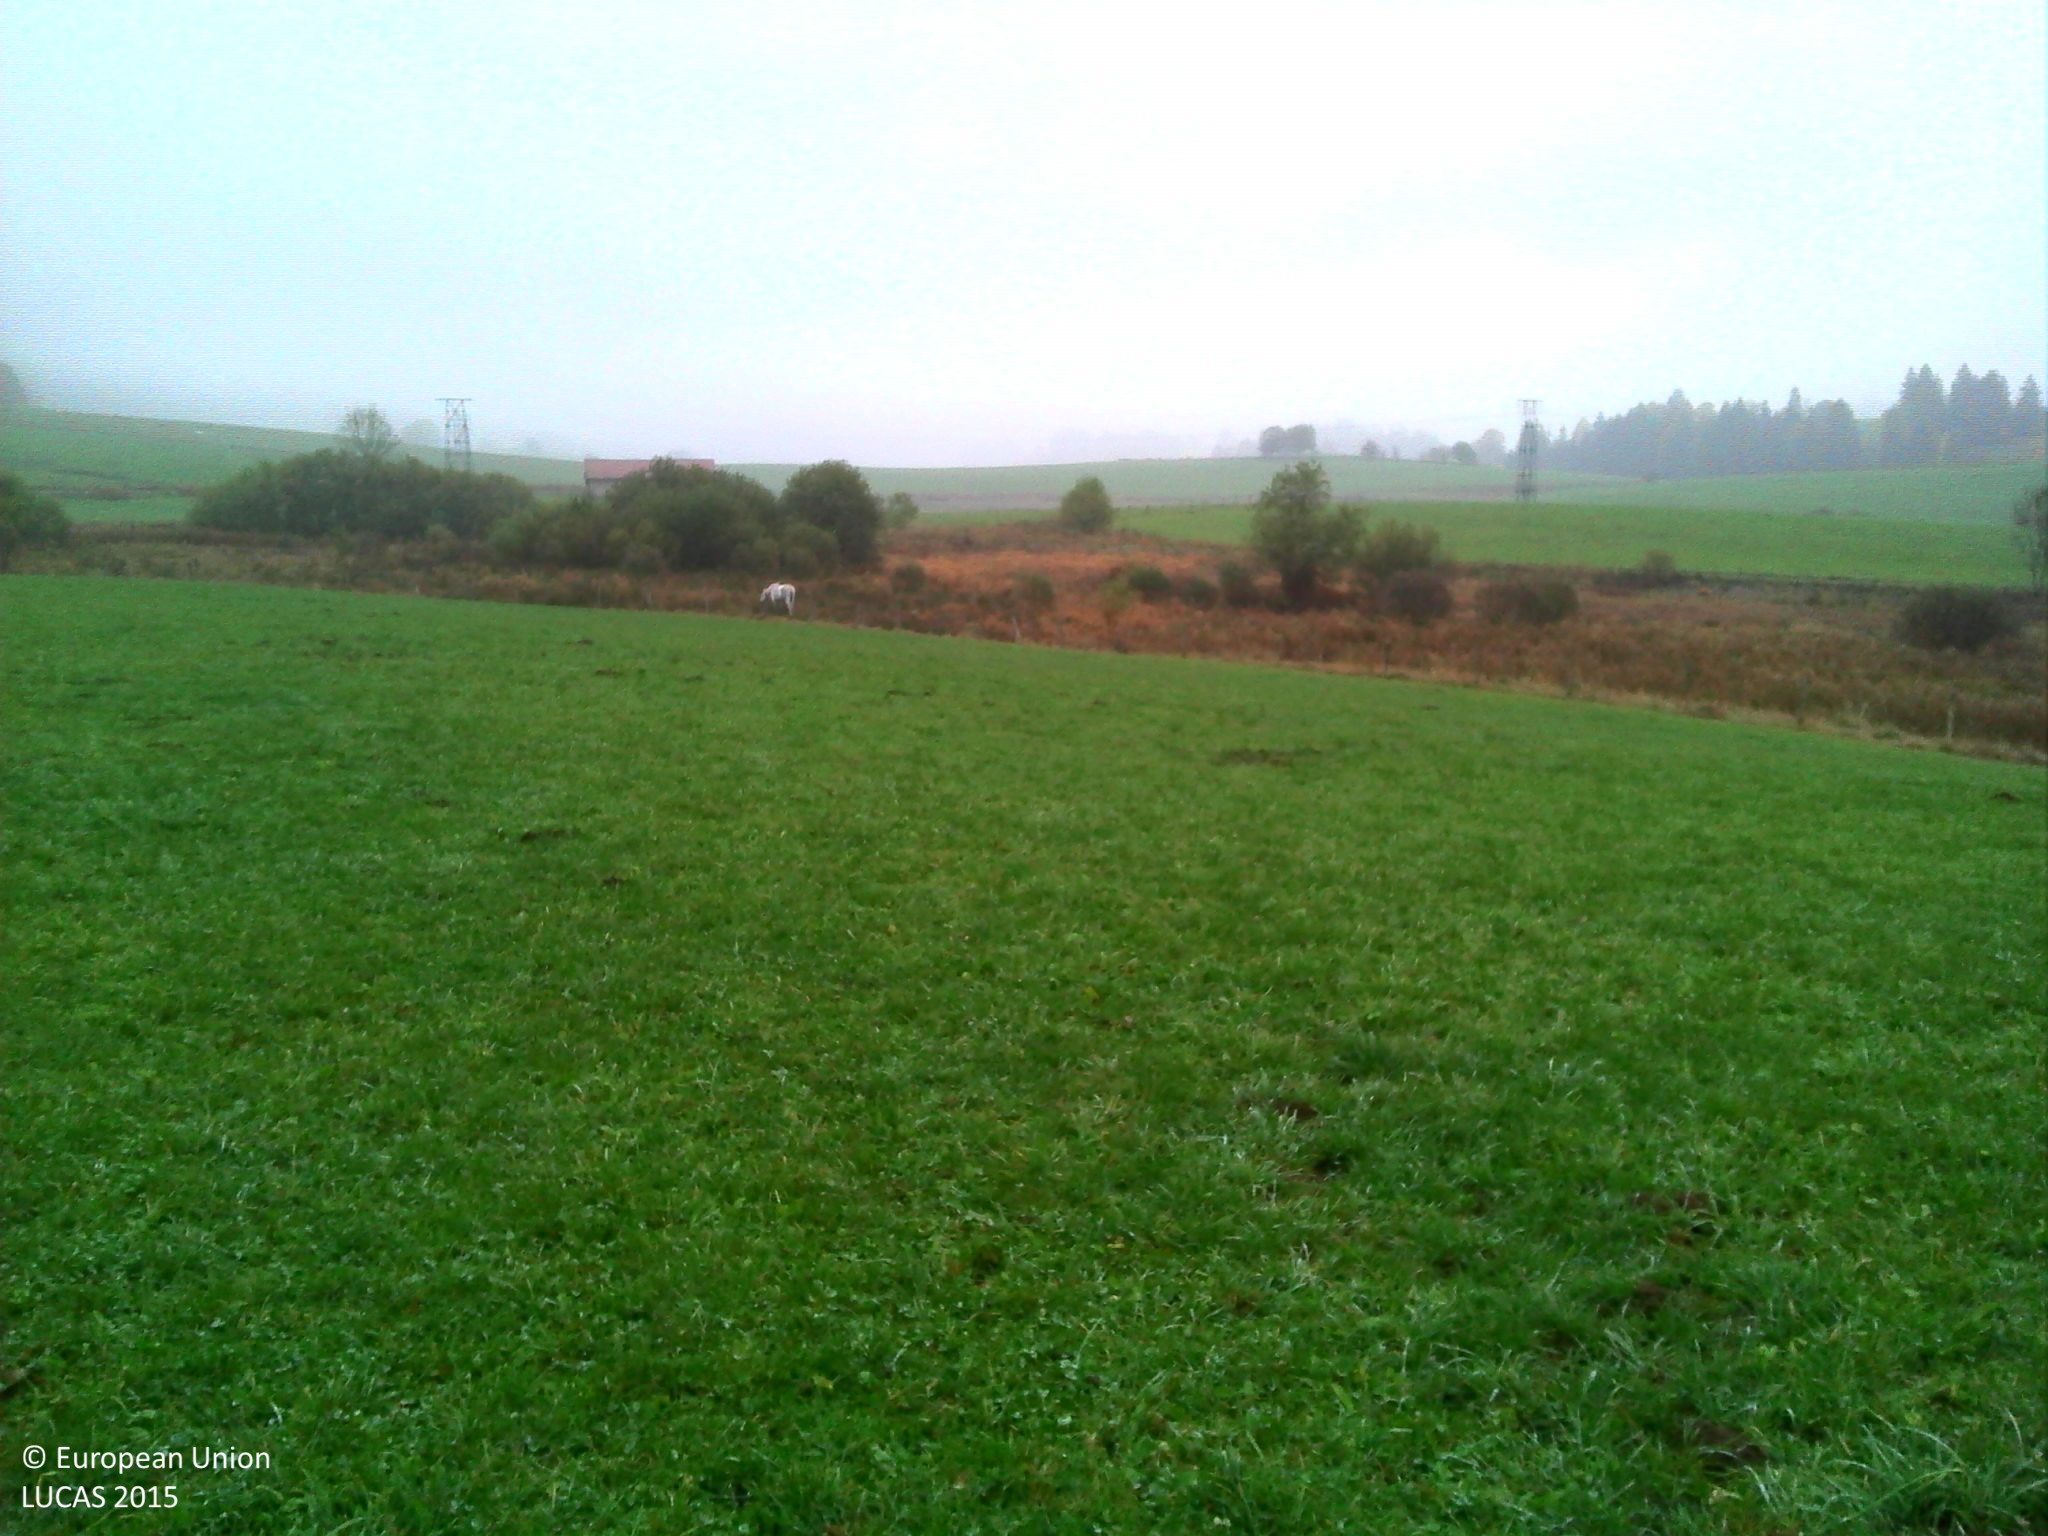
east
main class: Grassland
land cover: Grassland without tree/shrub cover
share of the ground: > 75 %
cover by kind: herbaceous plants 100 %
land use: Agriculture (excluding fallow land and kitchen gardens)
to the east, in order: Grassland without tree/shrub cover; Fences; Spontaneously vegetated surfaces; Peatbogs; Fences; Grass margins; Tracks; Grassland without tree/shrub cover; Electric lines; Grassland without tree/shrub cover
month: October
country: FR
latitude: 46.8458
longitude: 6.2913
